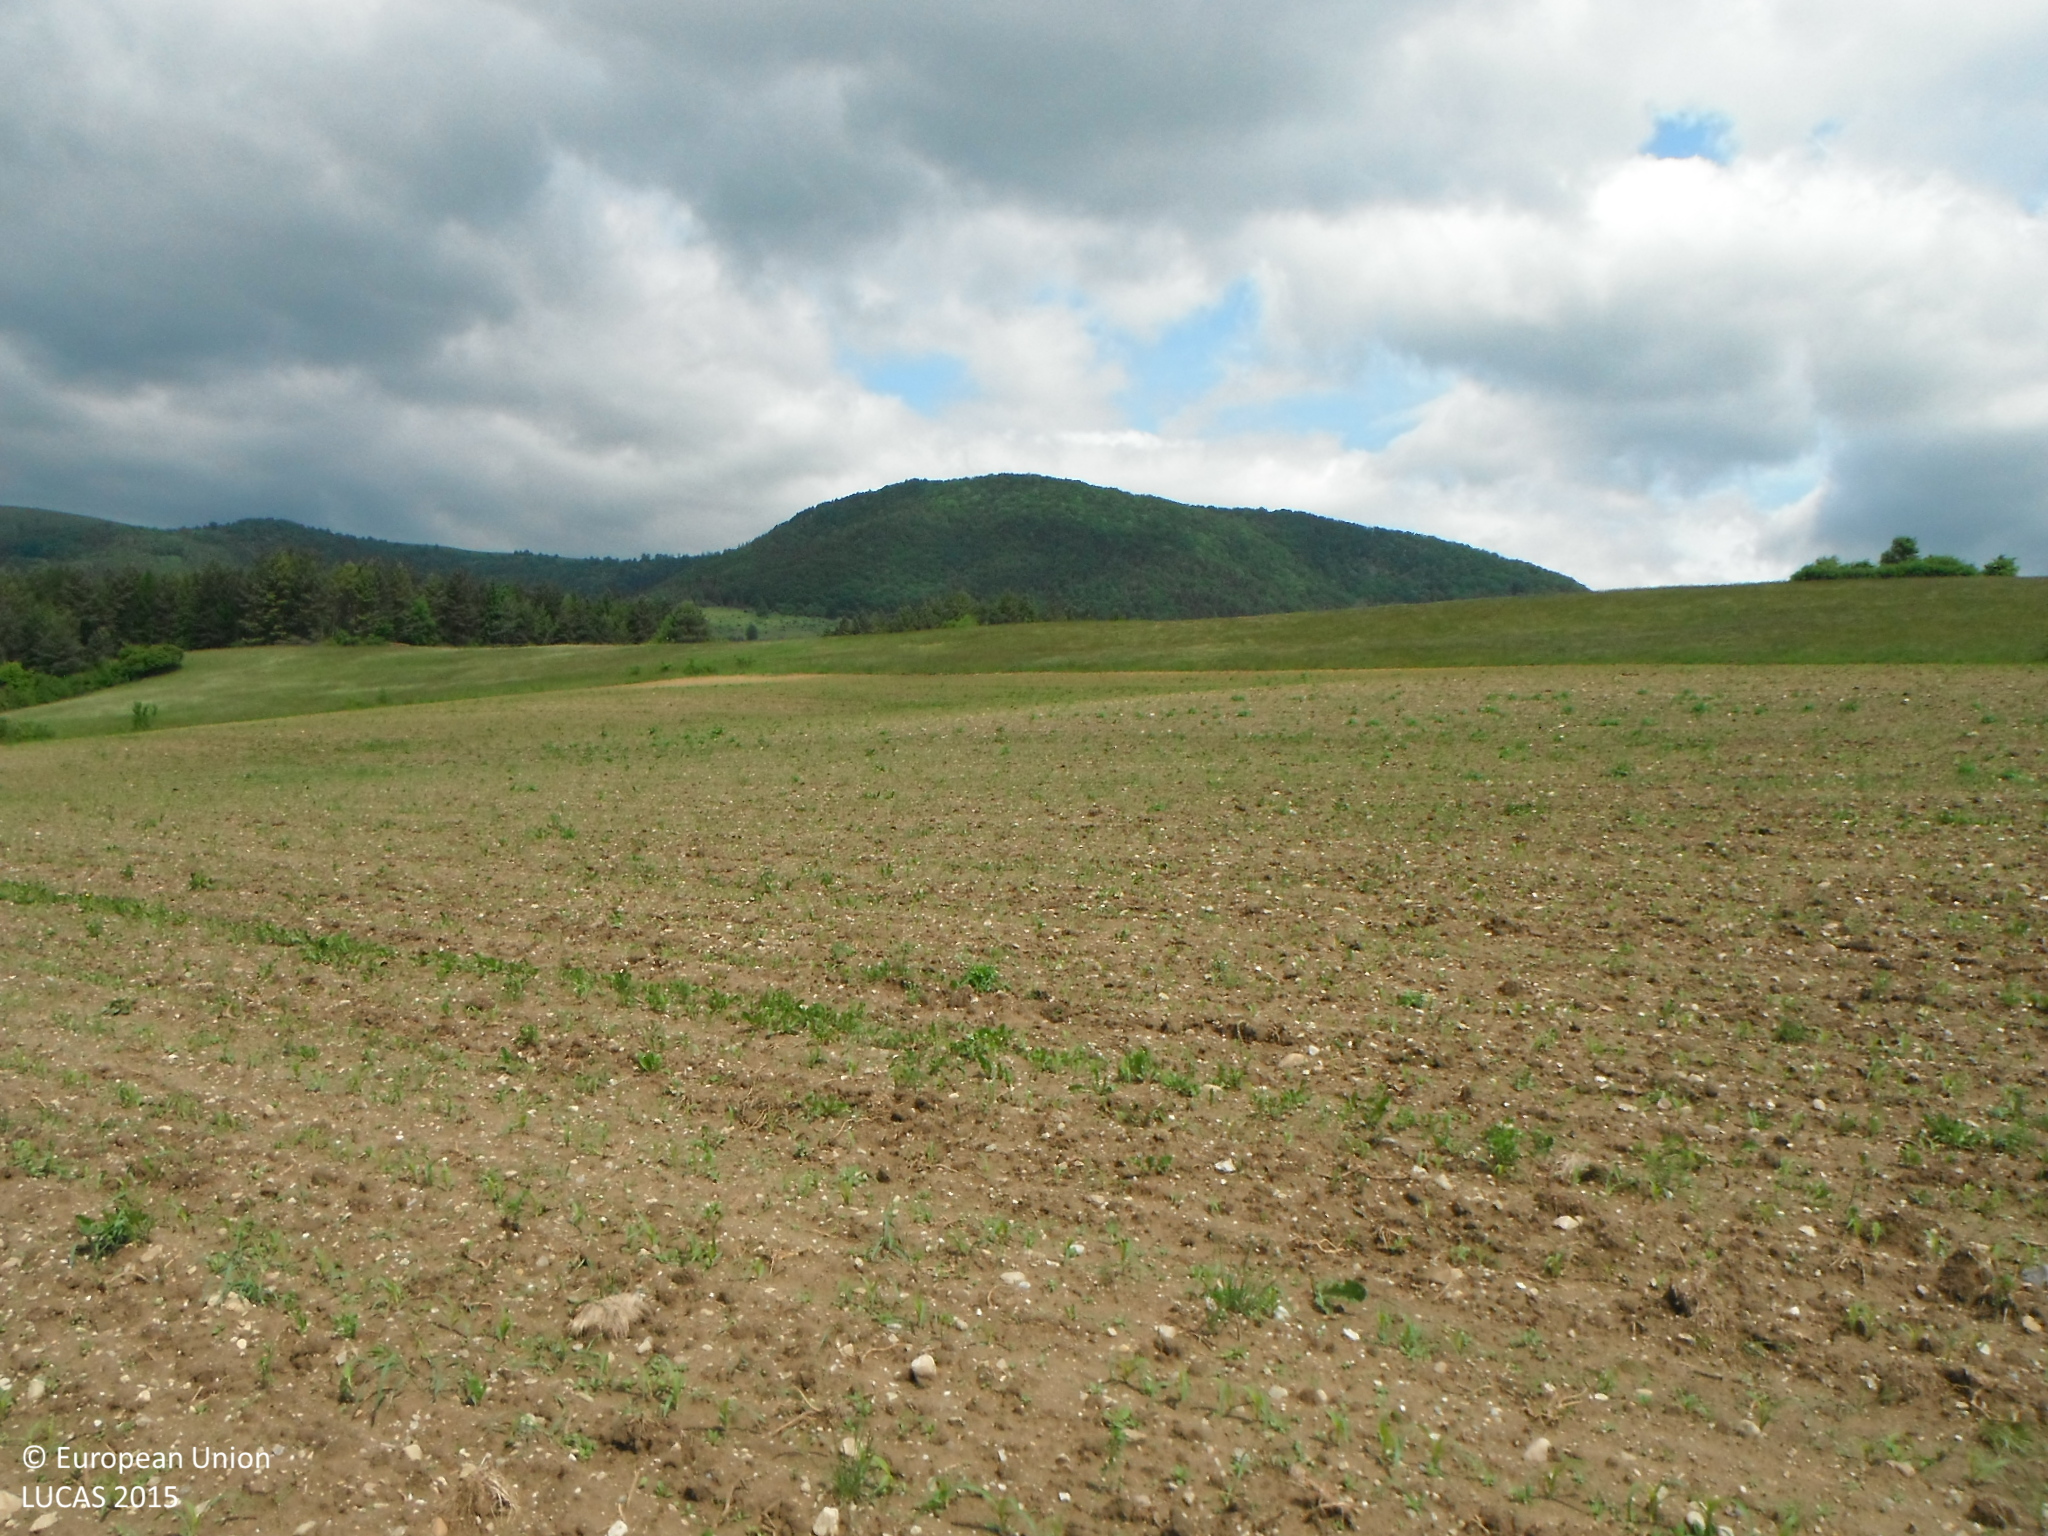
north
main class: Artificial land
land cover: Other artificial areas
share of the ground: > 75 %
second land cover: Maize
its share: < 10 %
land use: Electricity, gas and thermal power distribution
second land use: Agriculture (excluding fallow land and kitchen gardens)
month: May
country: SK
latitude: 48.7923
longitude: 19.2661
